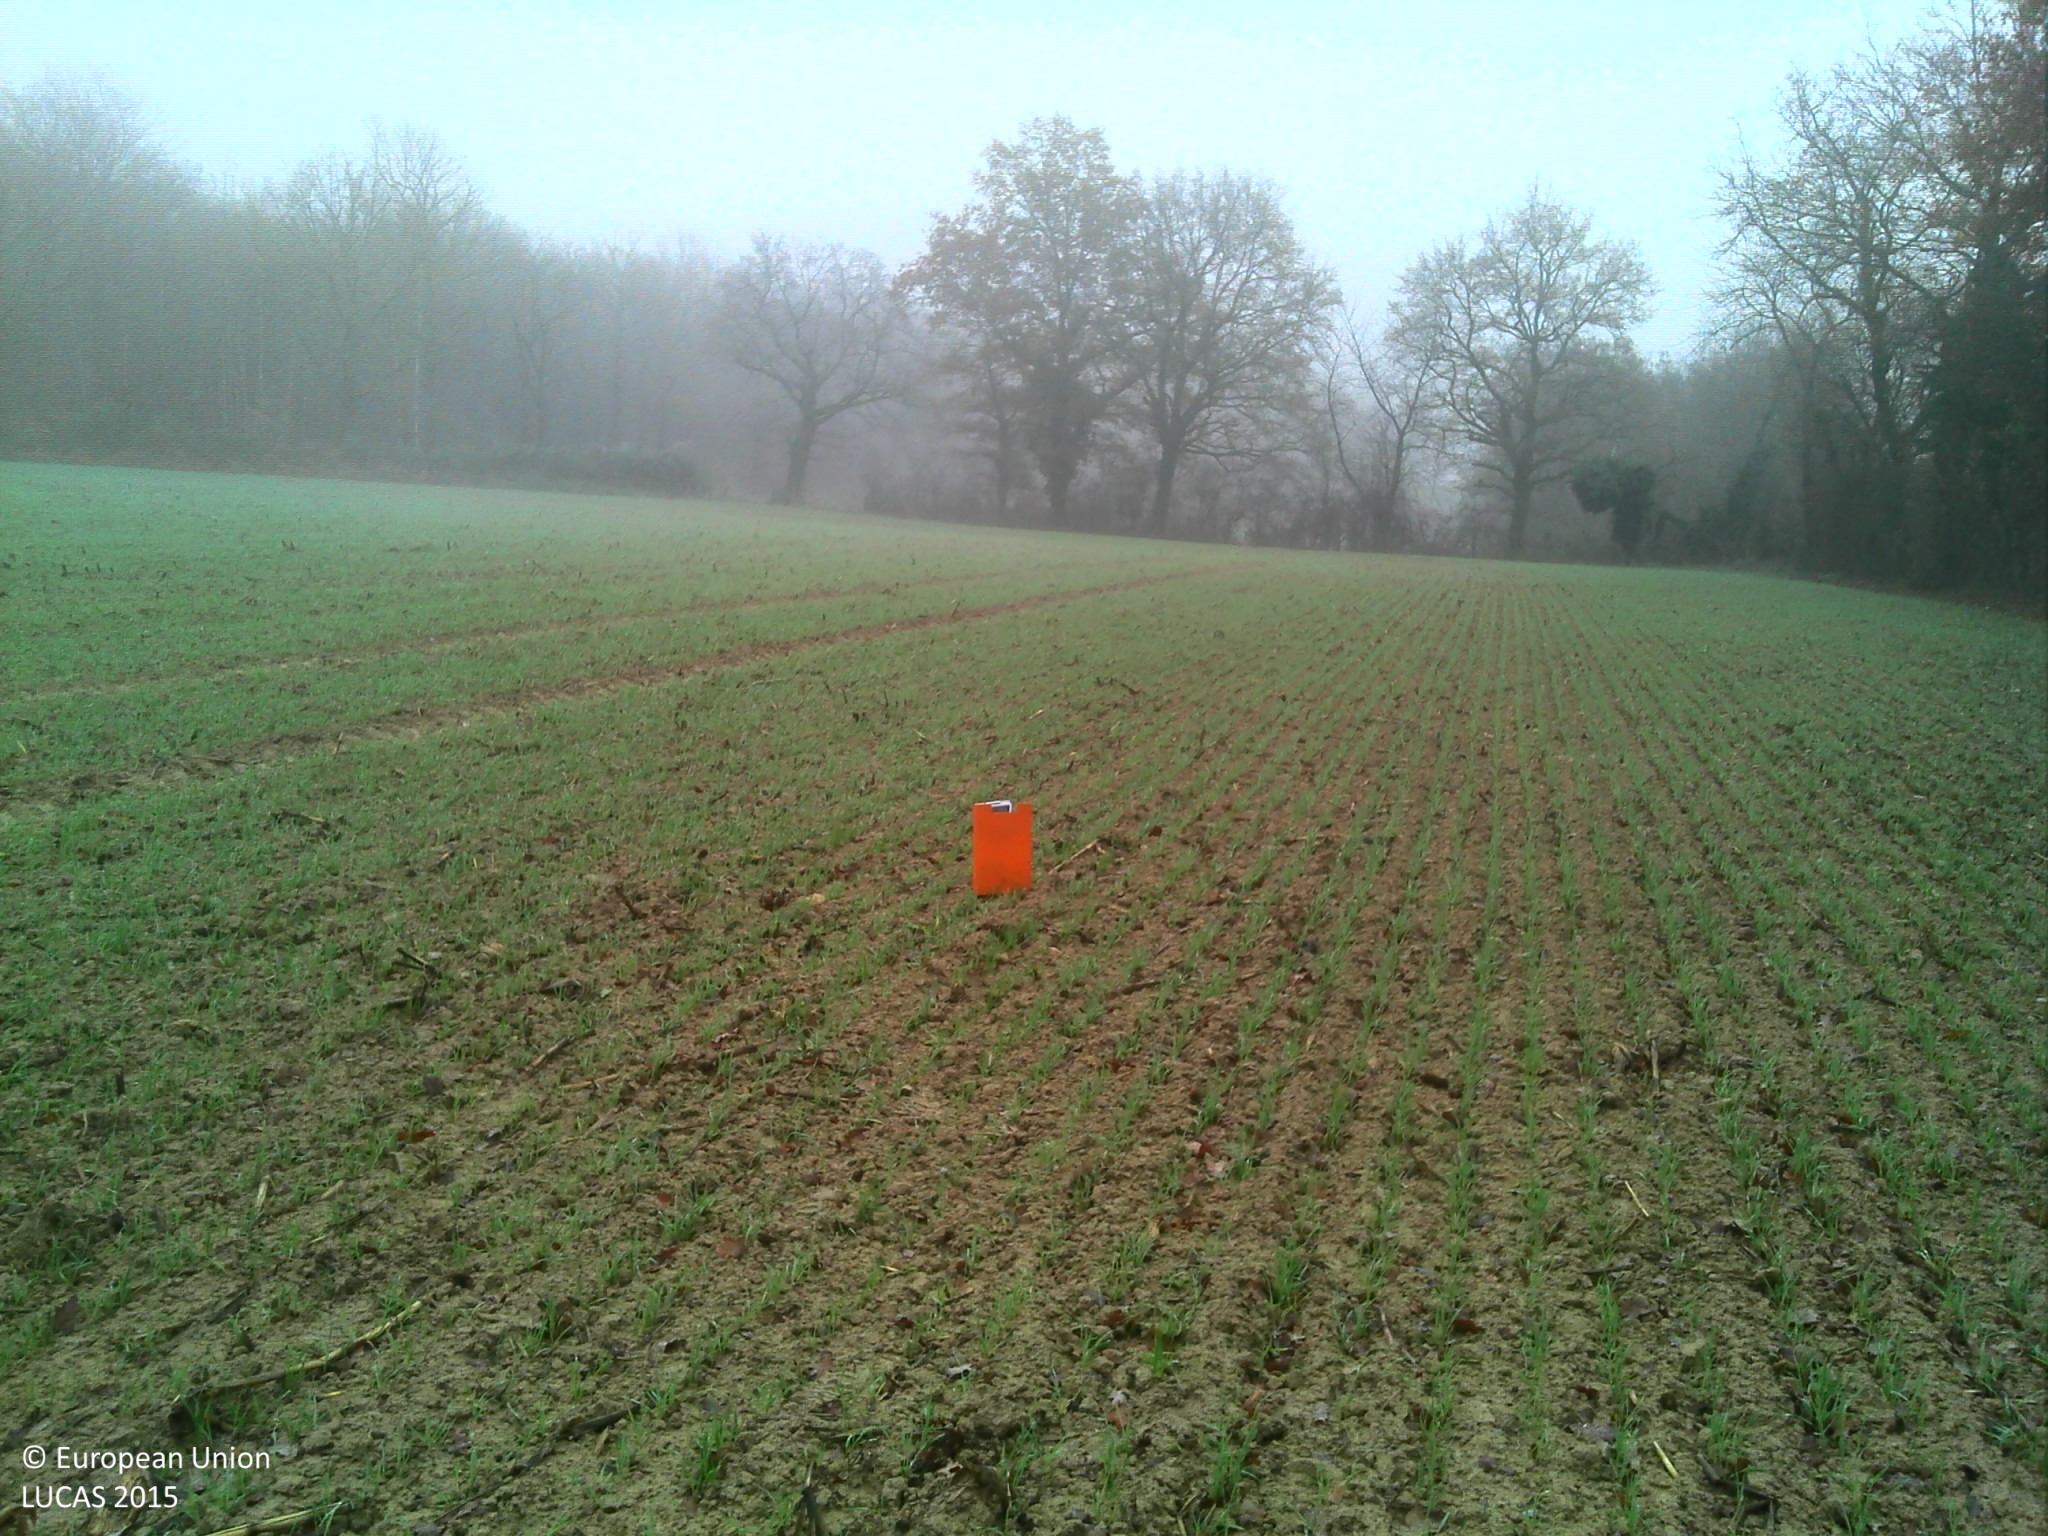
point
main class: Cropland
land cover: Common wheat
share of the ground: 50 - 75 %
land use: Agriculture (excluding fallow land and kitchen gardens)
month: November
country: FR
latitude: 46.5418
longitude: 3.6486
